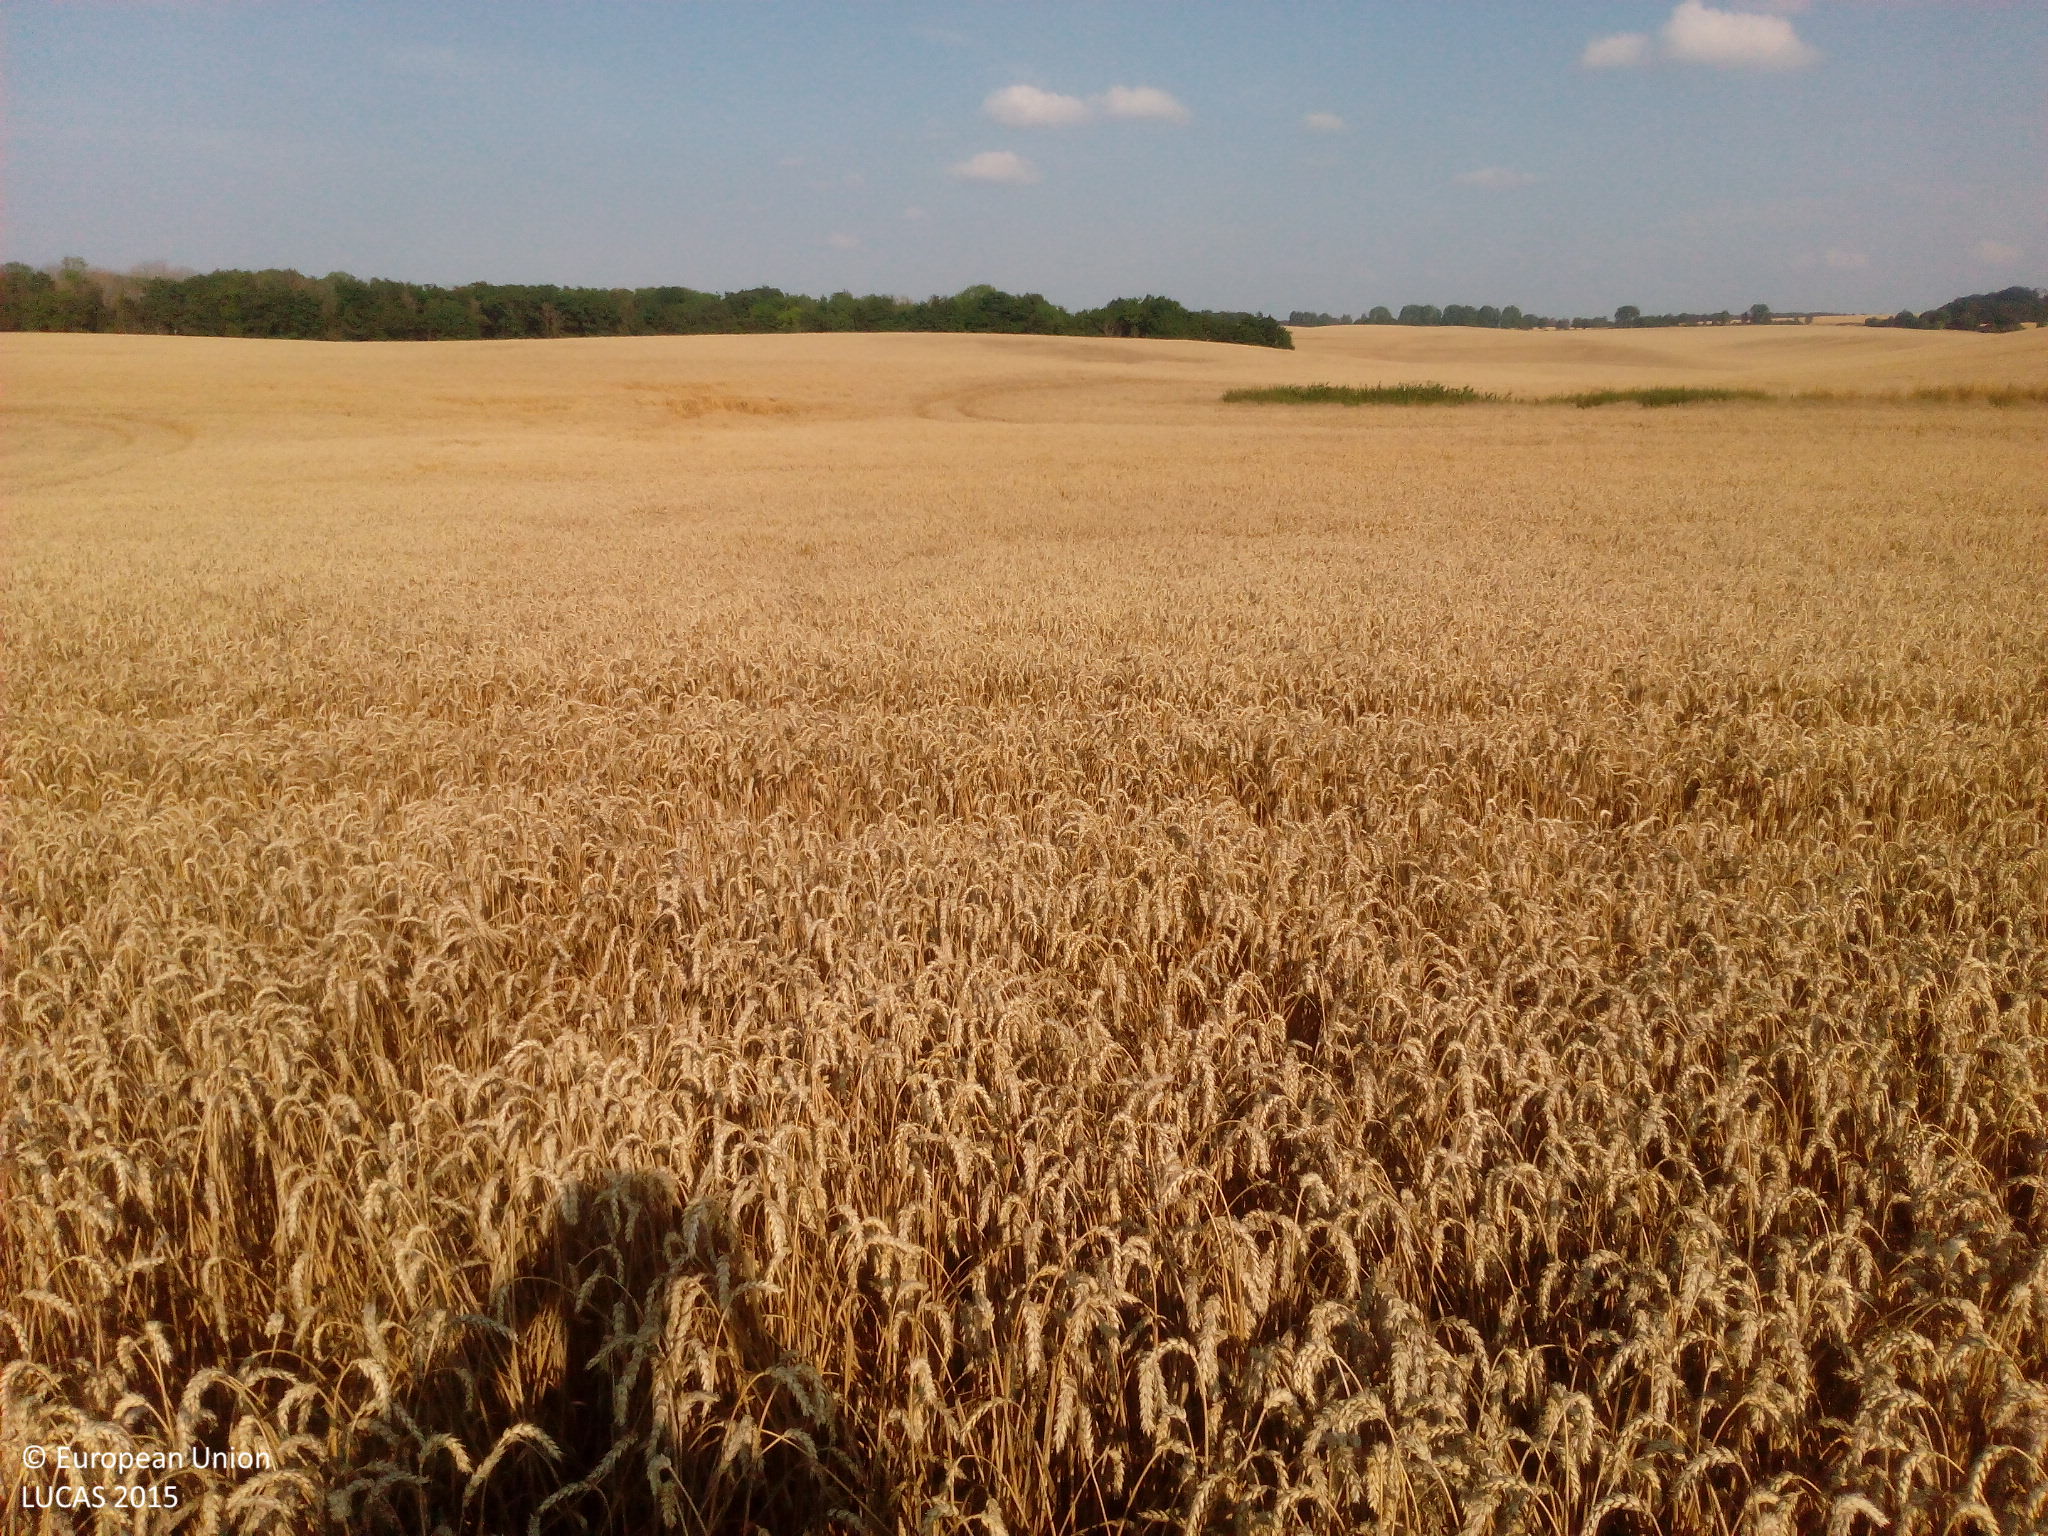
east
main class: Cropland
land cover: Common wheat
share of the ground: > 75 %
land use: Agriculture (excluding fallow land and kitchen gardens)
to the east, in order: Common wheat
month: August
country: DE
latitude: 53.7678
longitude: 12.6846
